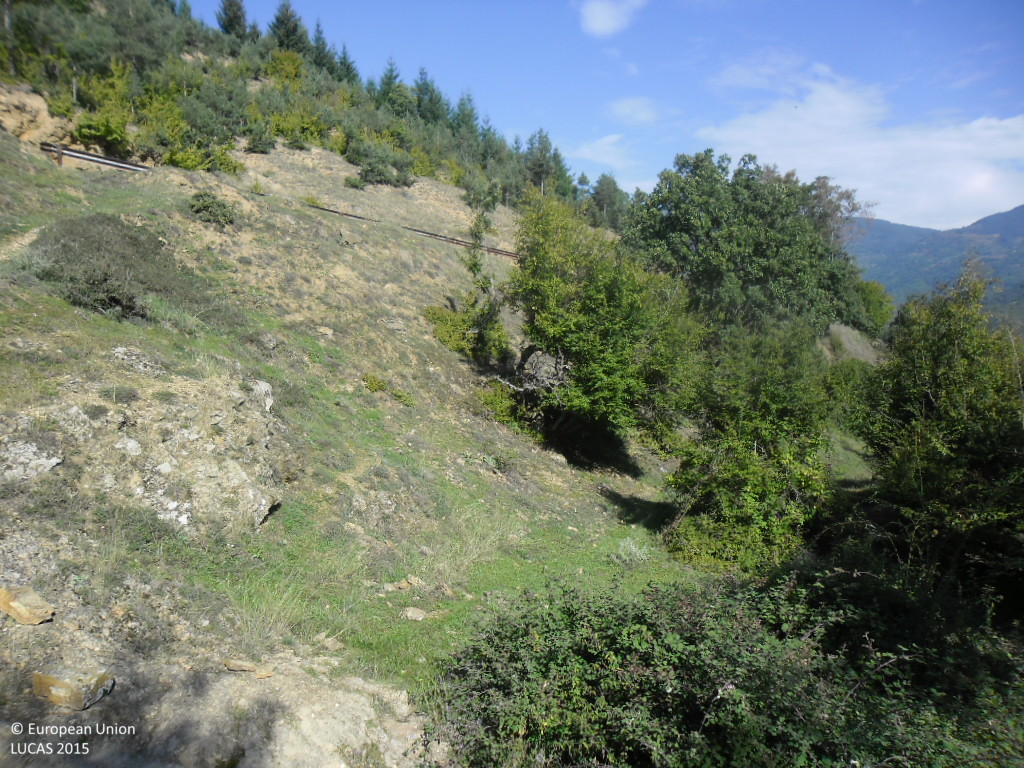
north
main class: Grassland
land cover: Grassland with sparse tree/shrub cover
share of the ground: > 75 %
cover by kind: herbaceous plants 90 %, broadleaved forest trees 5 %, shrubs 5 %
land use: Agriculture (excluding fallow land and kitchen gardens)
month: October
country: BG
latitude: 41.4463
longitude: 23.0040
